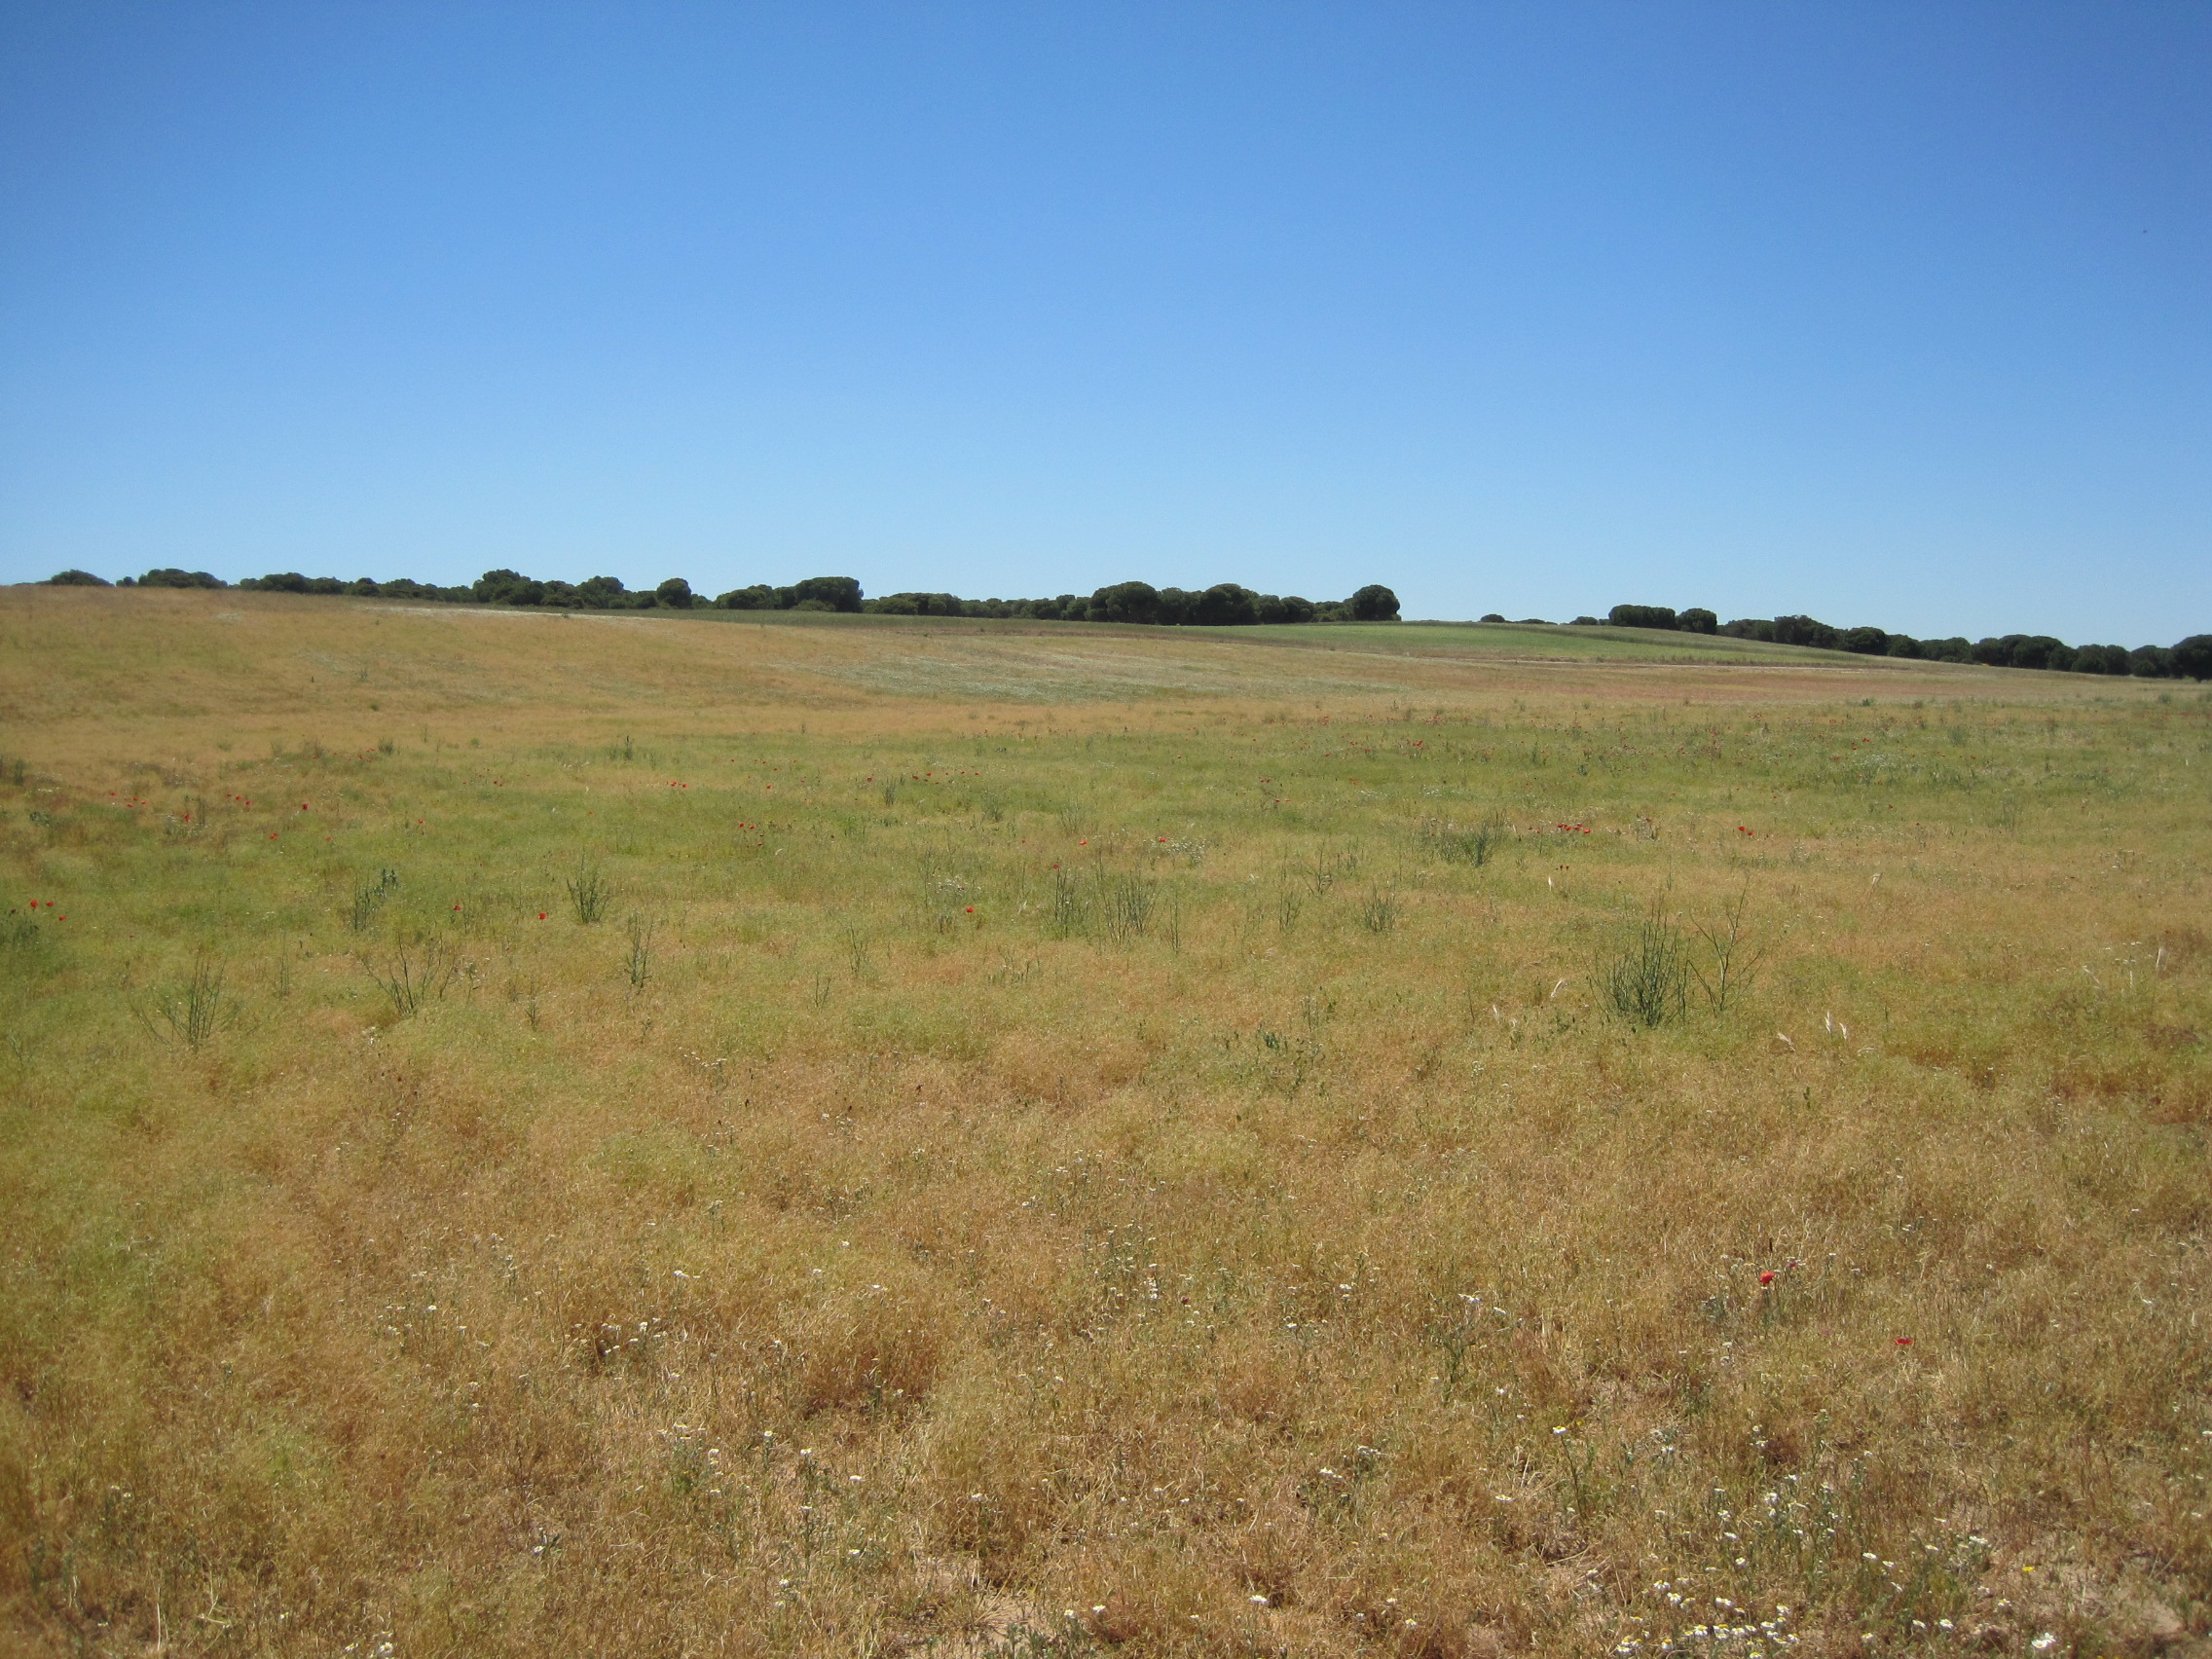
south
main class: Cropland
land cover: Dry pulses
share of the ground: > 75 %
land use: Agriculture (excluding fallow land and kitchen gardens)
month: May
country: ES
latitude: 41.2894
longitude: -5.2507
